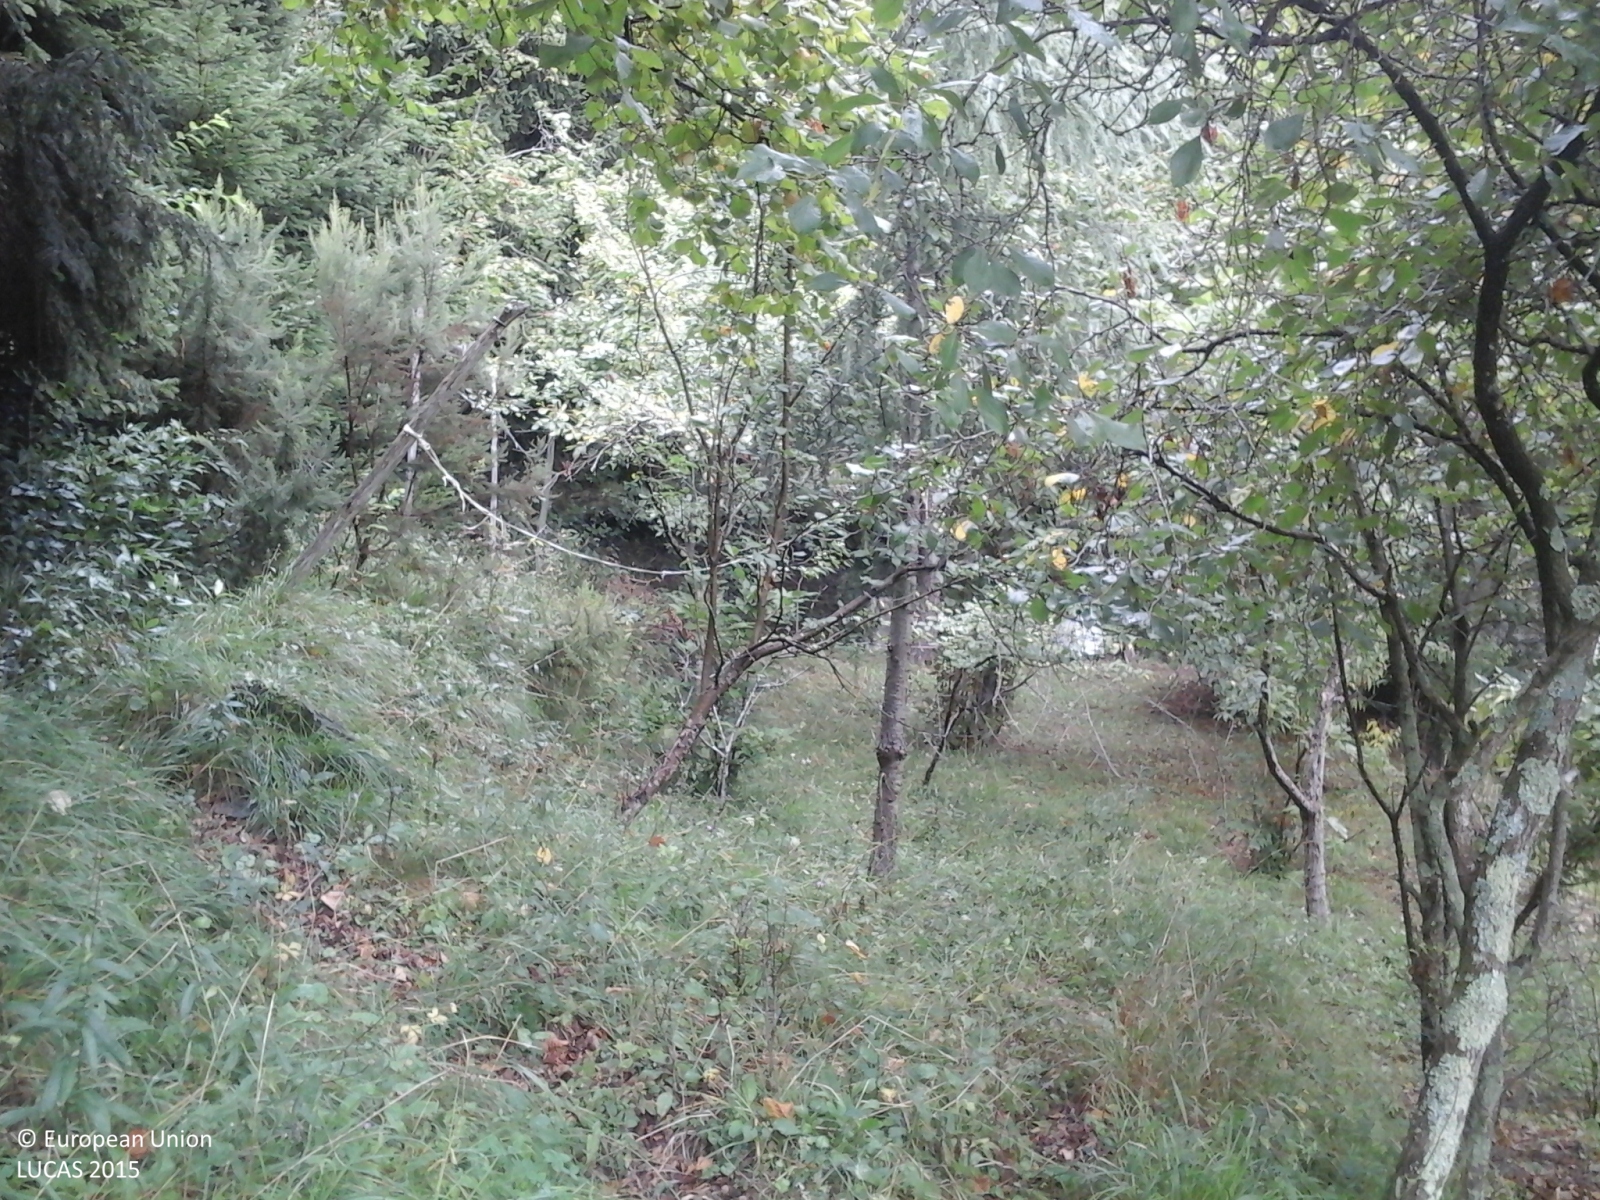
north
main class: Cropland
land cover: Nuts trees
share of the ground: > 75 %
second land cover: Grassland without tree/shrub cover
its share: > 75 %
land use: Agriculture (excluding fallow land and kitchen gardens)
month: September
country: IT
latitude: 44.4369
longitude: 9.1100
